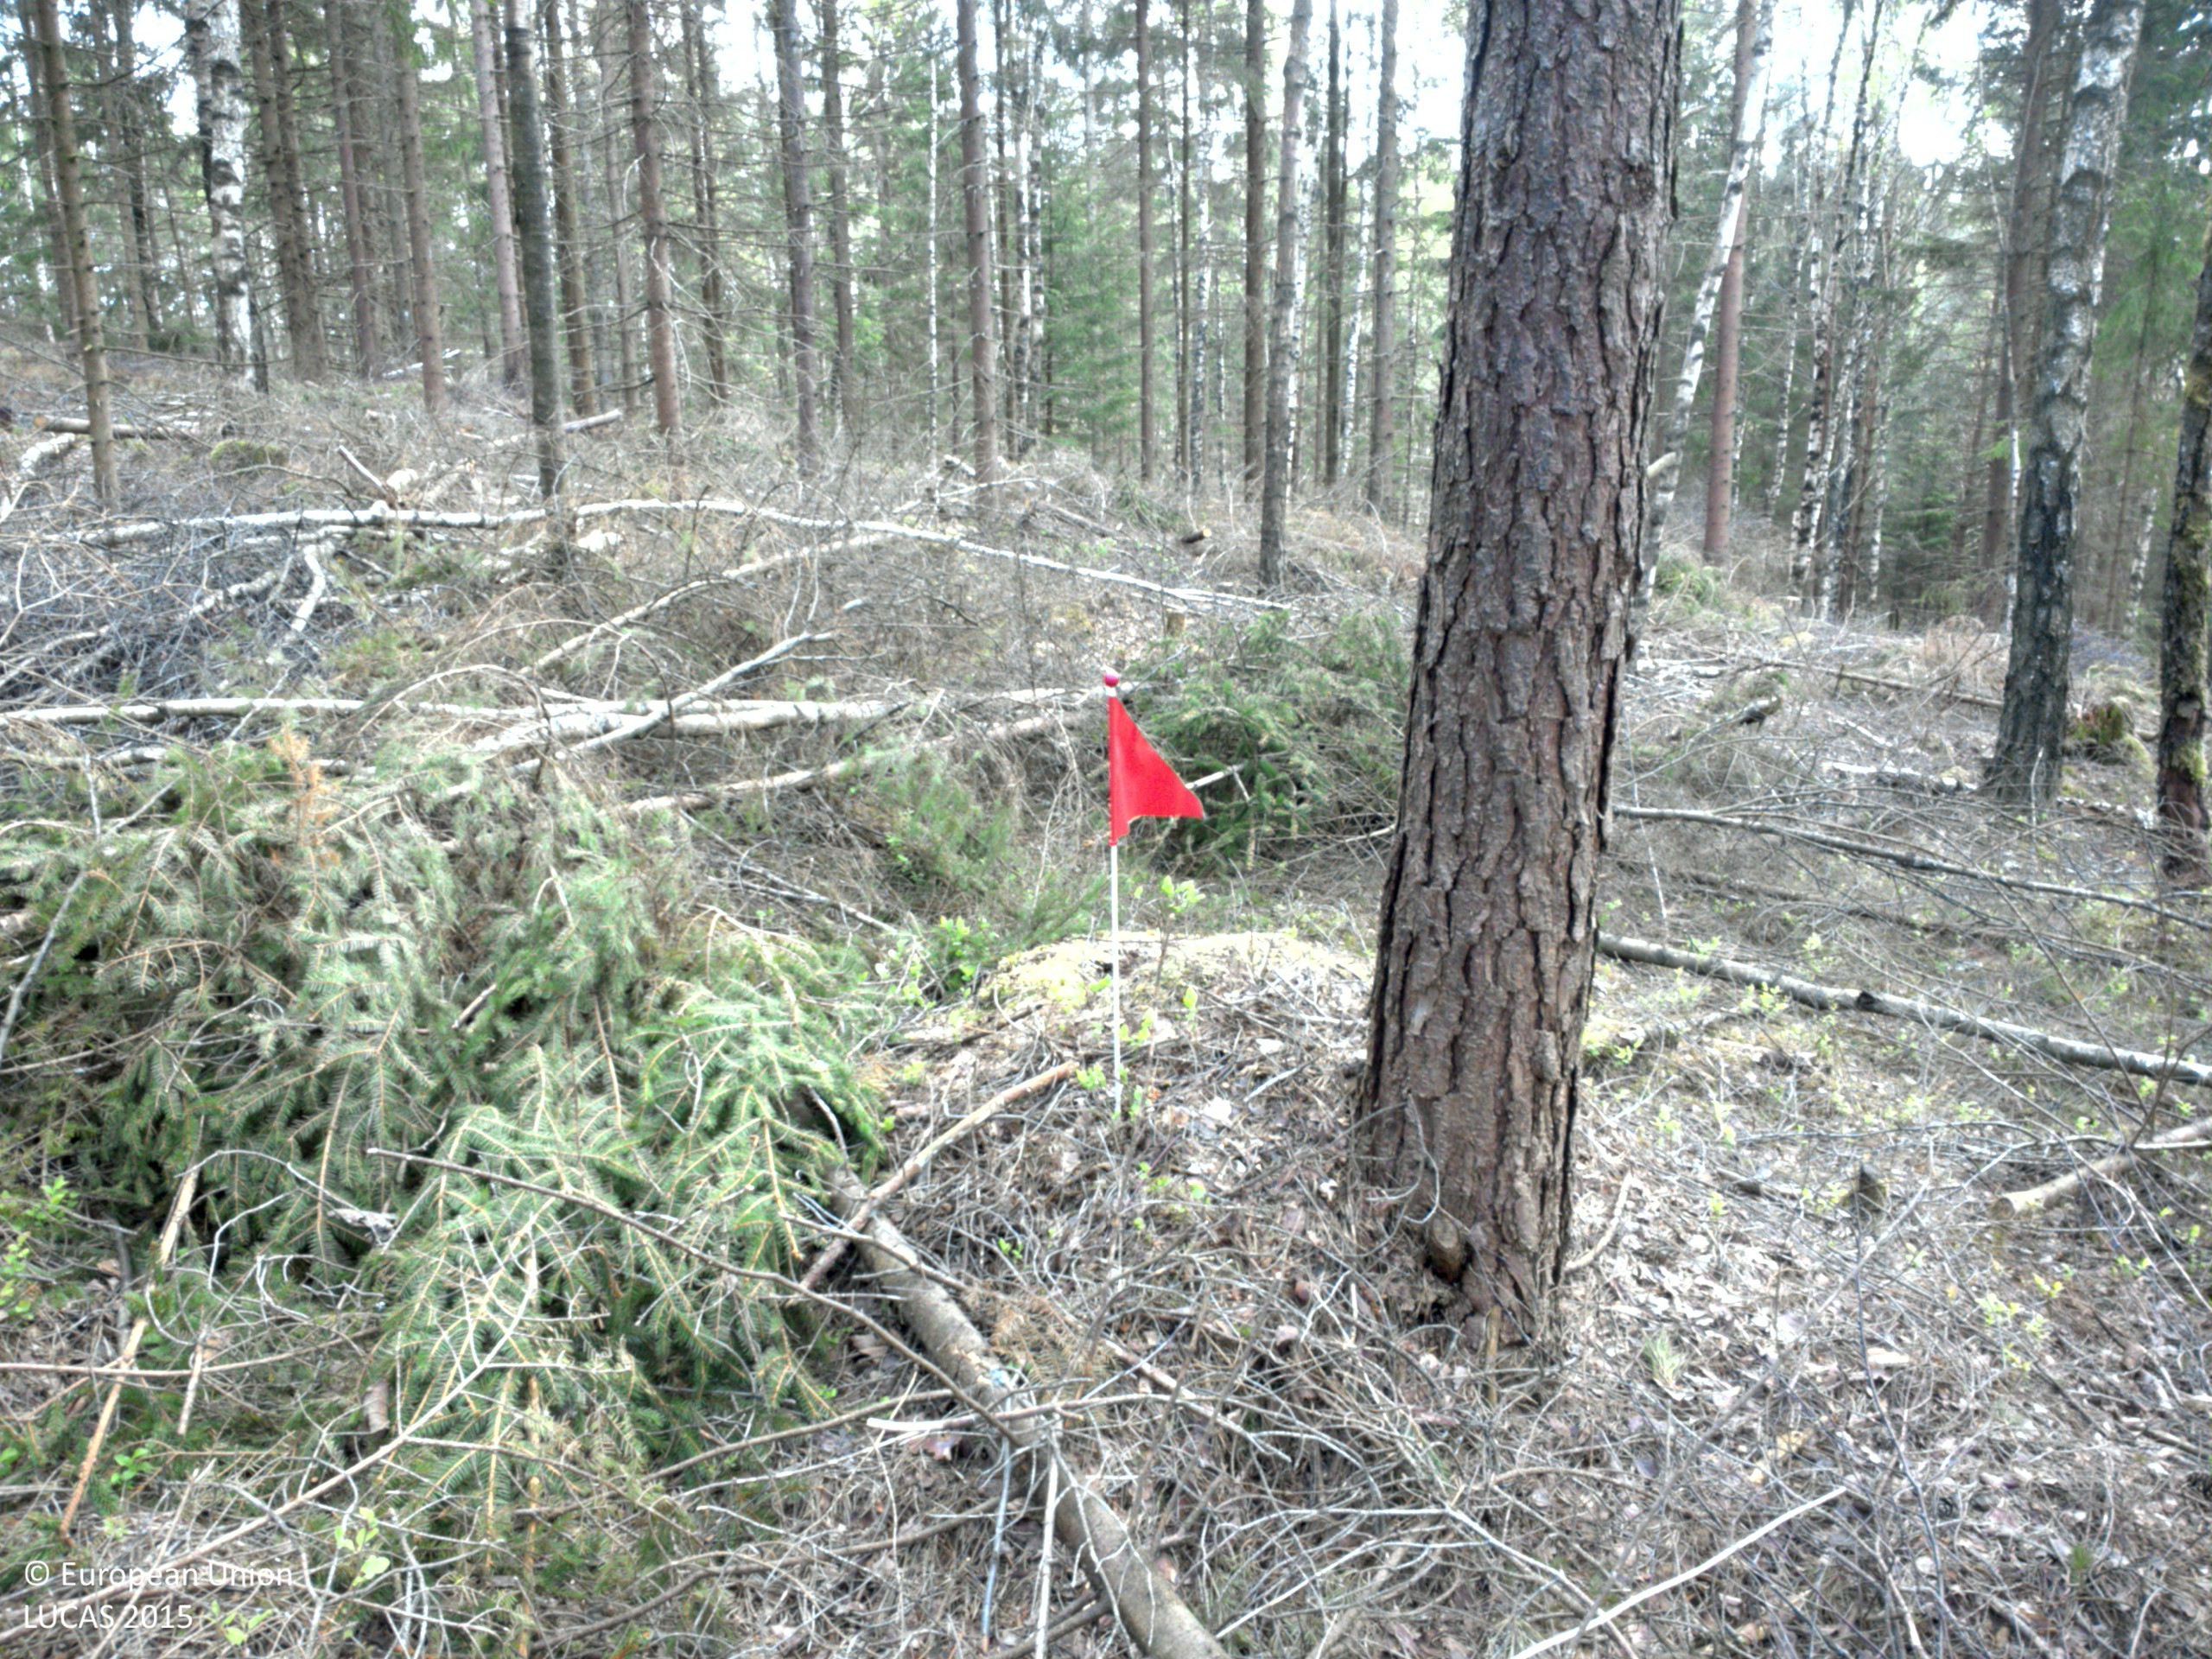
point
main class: Woodland
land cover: Spruce dominated mixed woodland
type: boreal forest
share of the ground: > 75 %
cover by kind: coniferous forest trees 60 %, broadleaved forest trees 20 %, shrubs 20 %
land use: Forestry
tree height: > 5 m
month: May
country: SE
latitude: 57.6243
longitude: 12.2903
